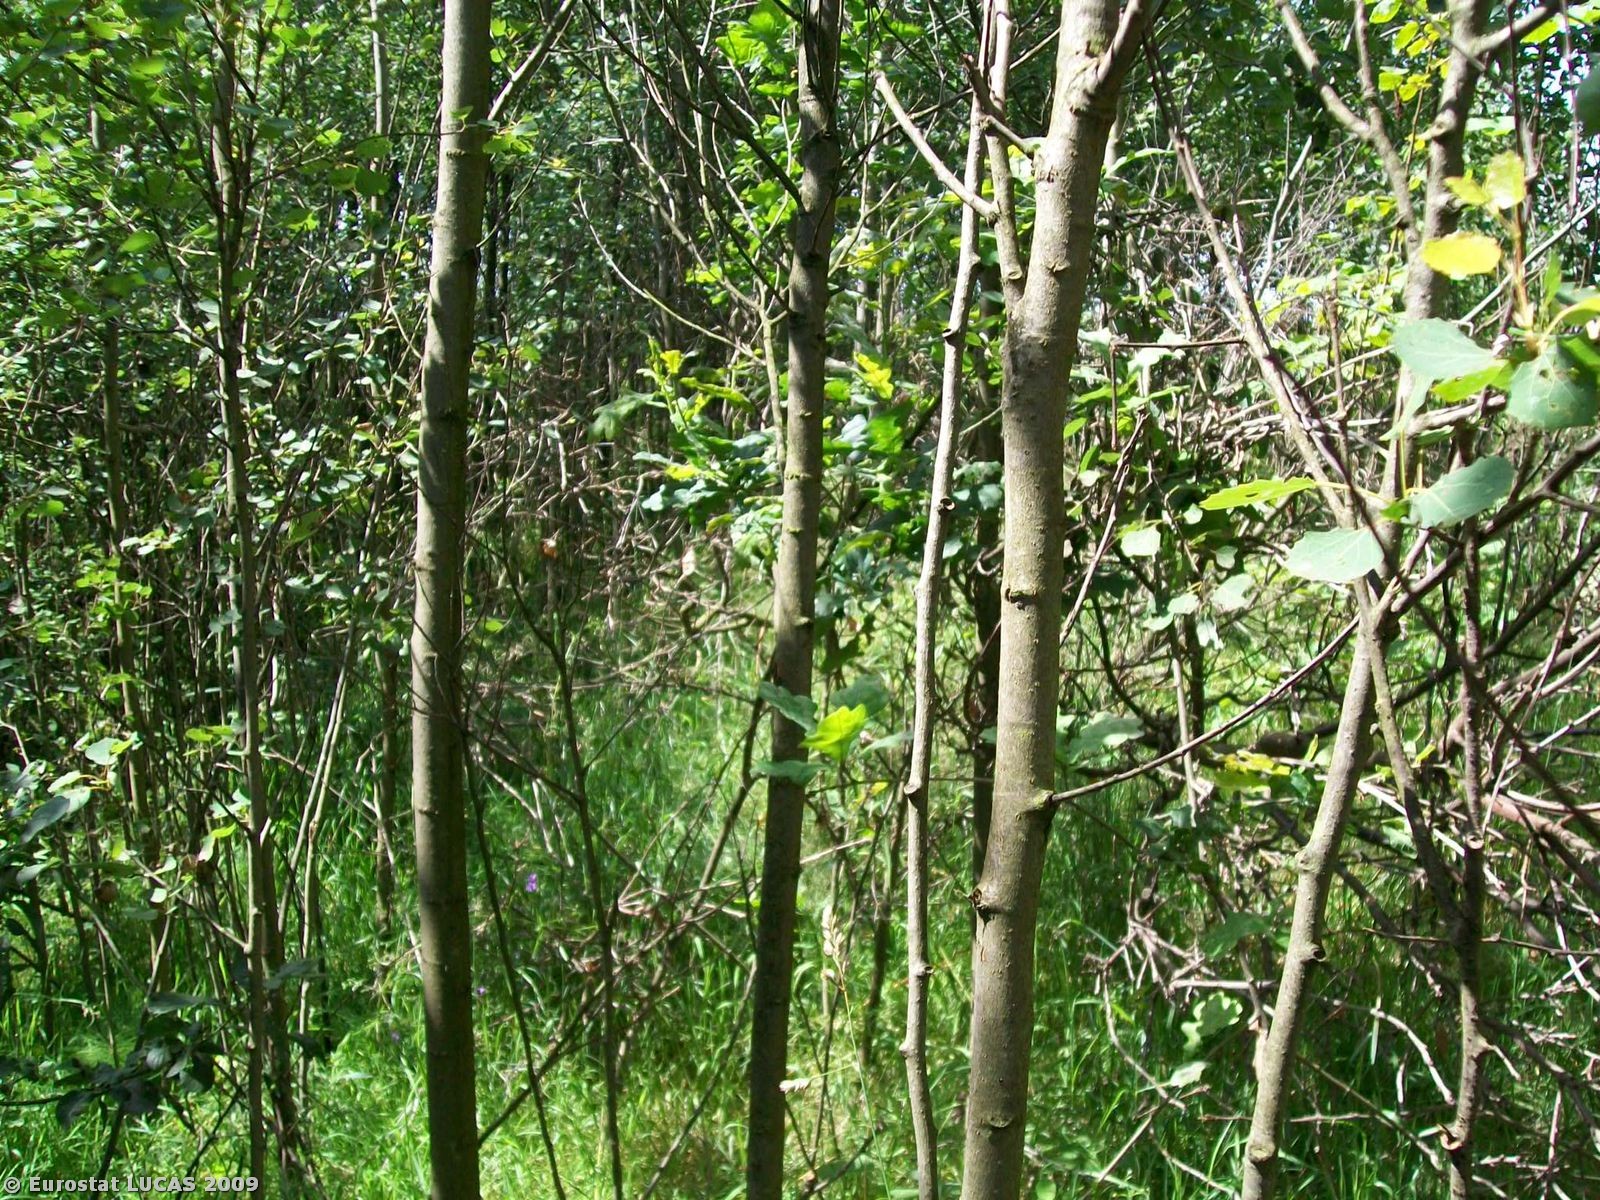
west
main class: Woodland
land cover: Broadleaved woodland
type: non-riverine alder, birch or aspen forest
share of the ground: > 75 %
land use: Unused
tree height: > 5 m
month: July
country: PL
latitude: 51.0599
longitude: 15.1255
